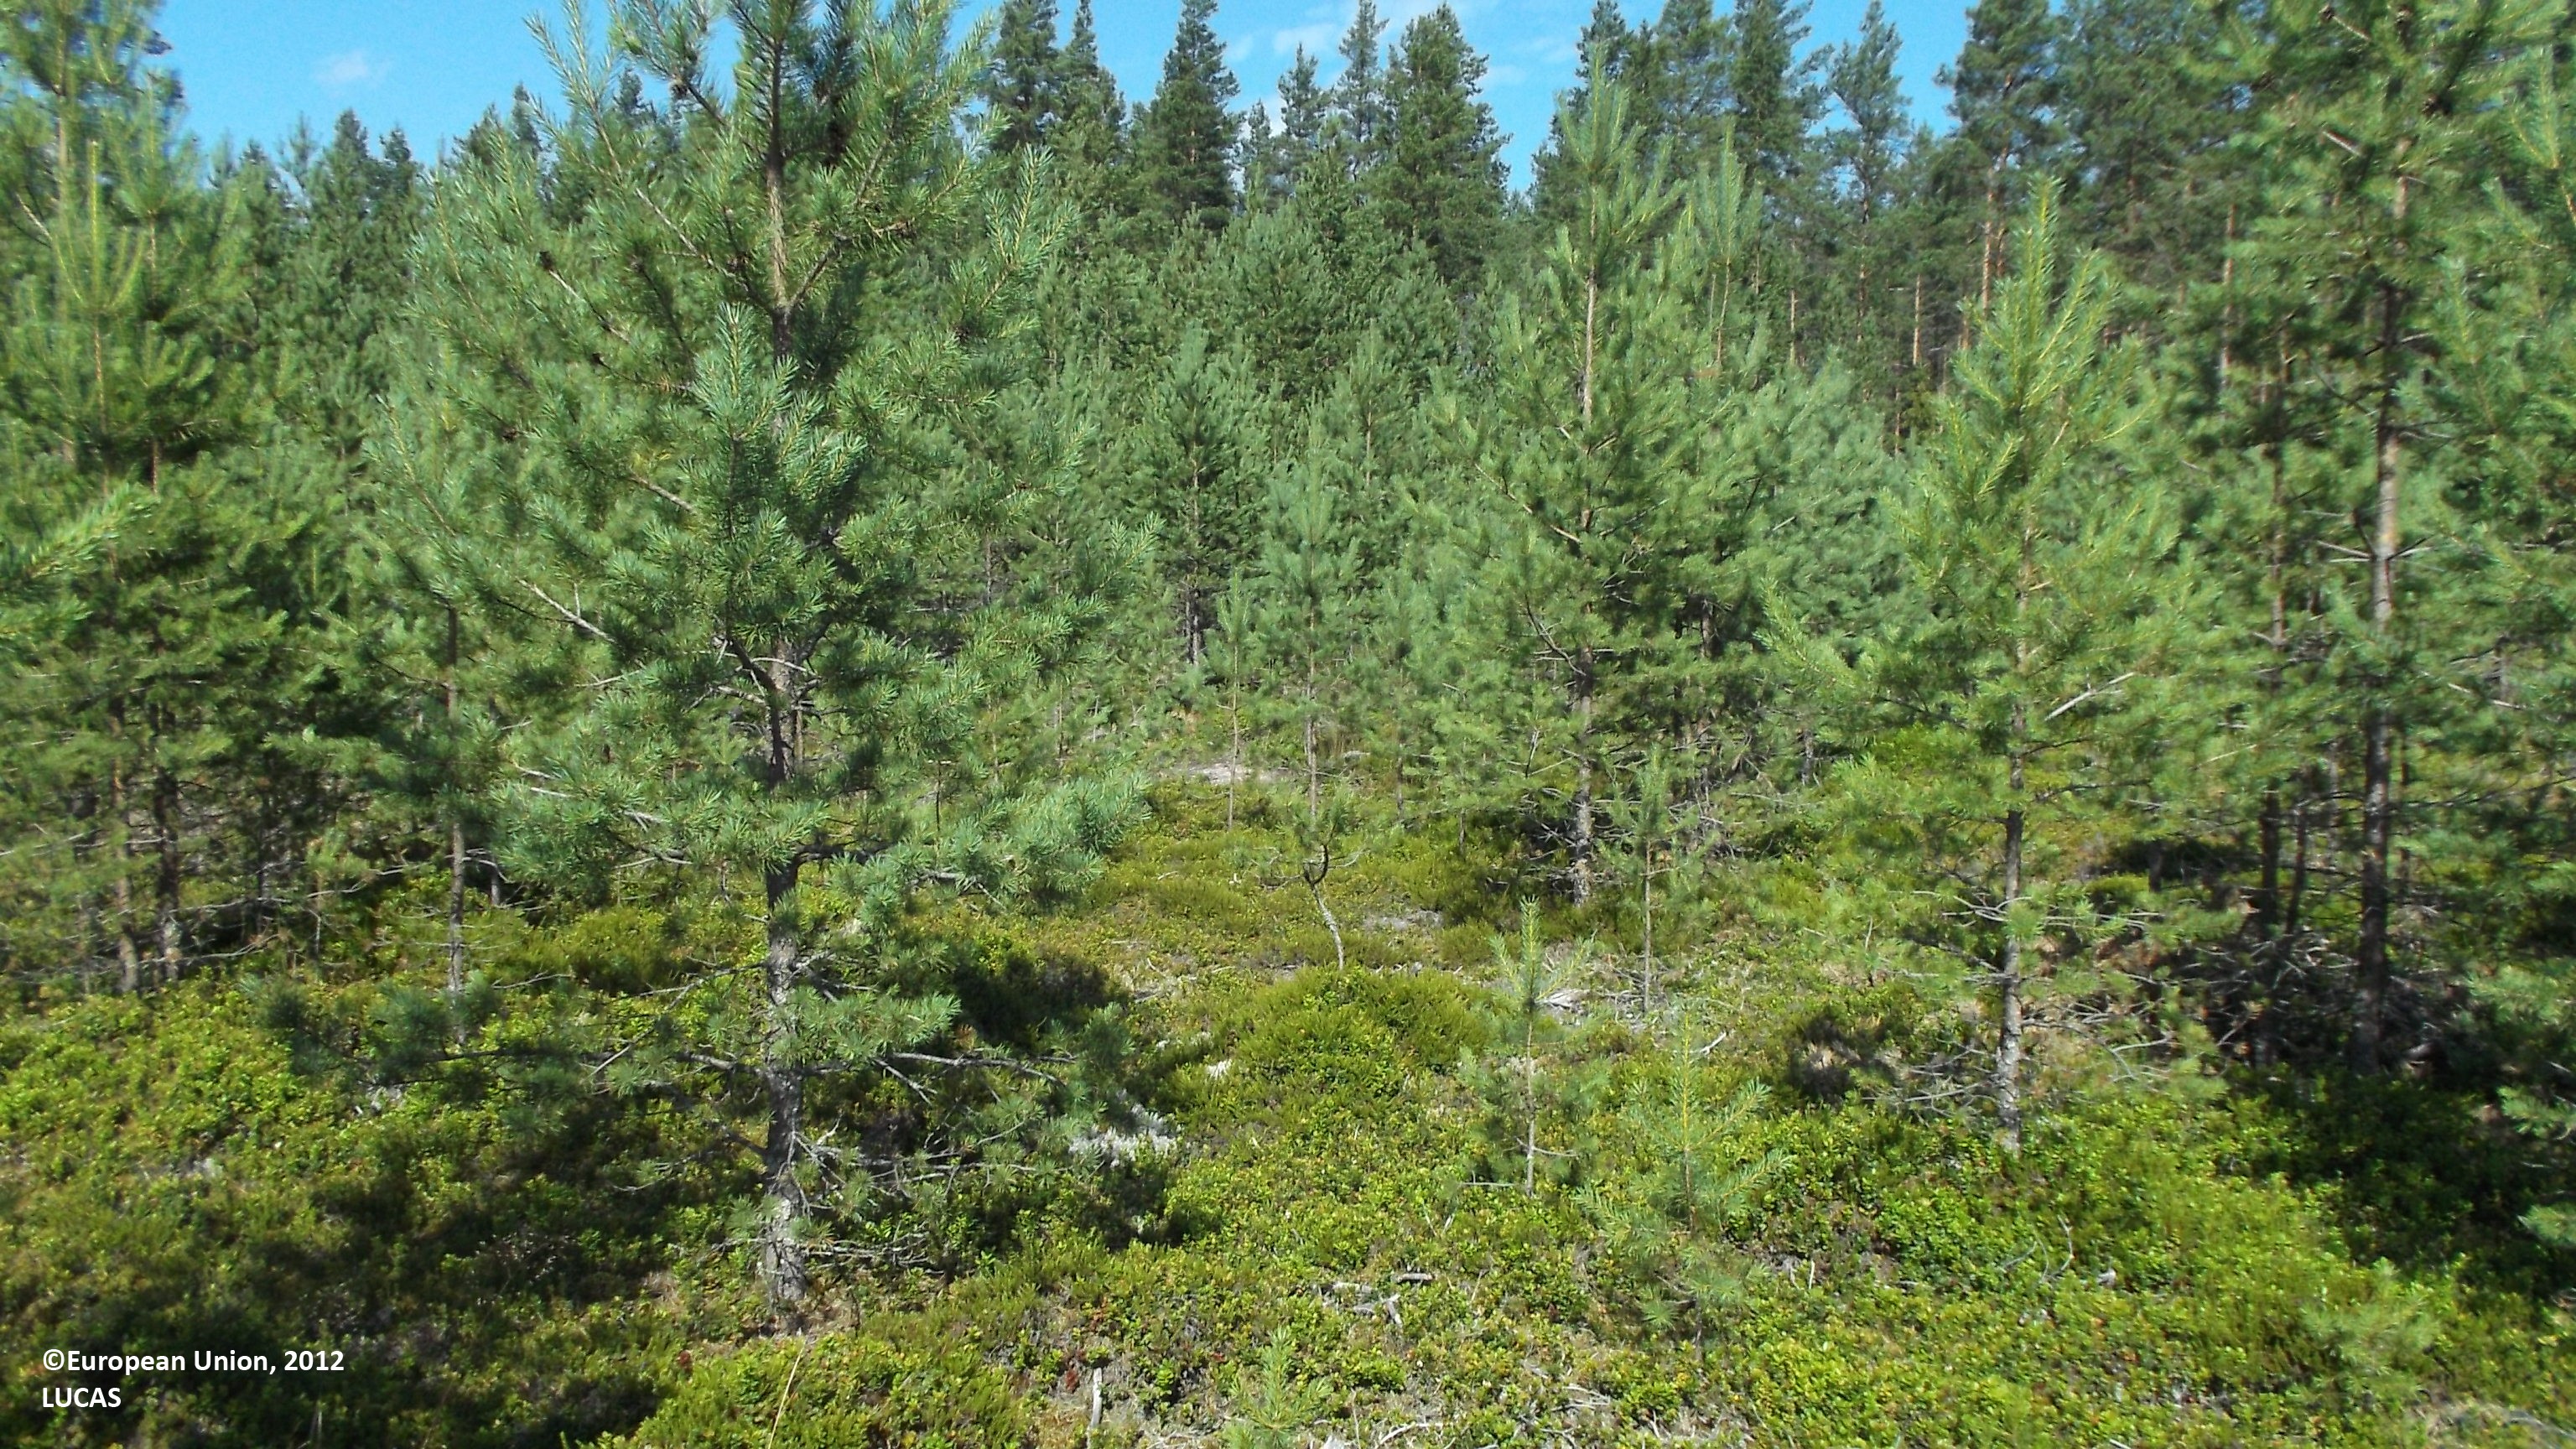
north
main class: Woodland
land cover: Pine dominated coniferous woodland
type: boreal forest
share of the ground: 25 - 50 %
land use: Forestry
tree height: < 5 m
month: July
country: FI
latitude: 63.8036
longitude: 23.0256
